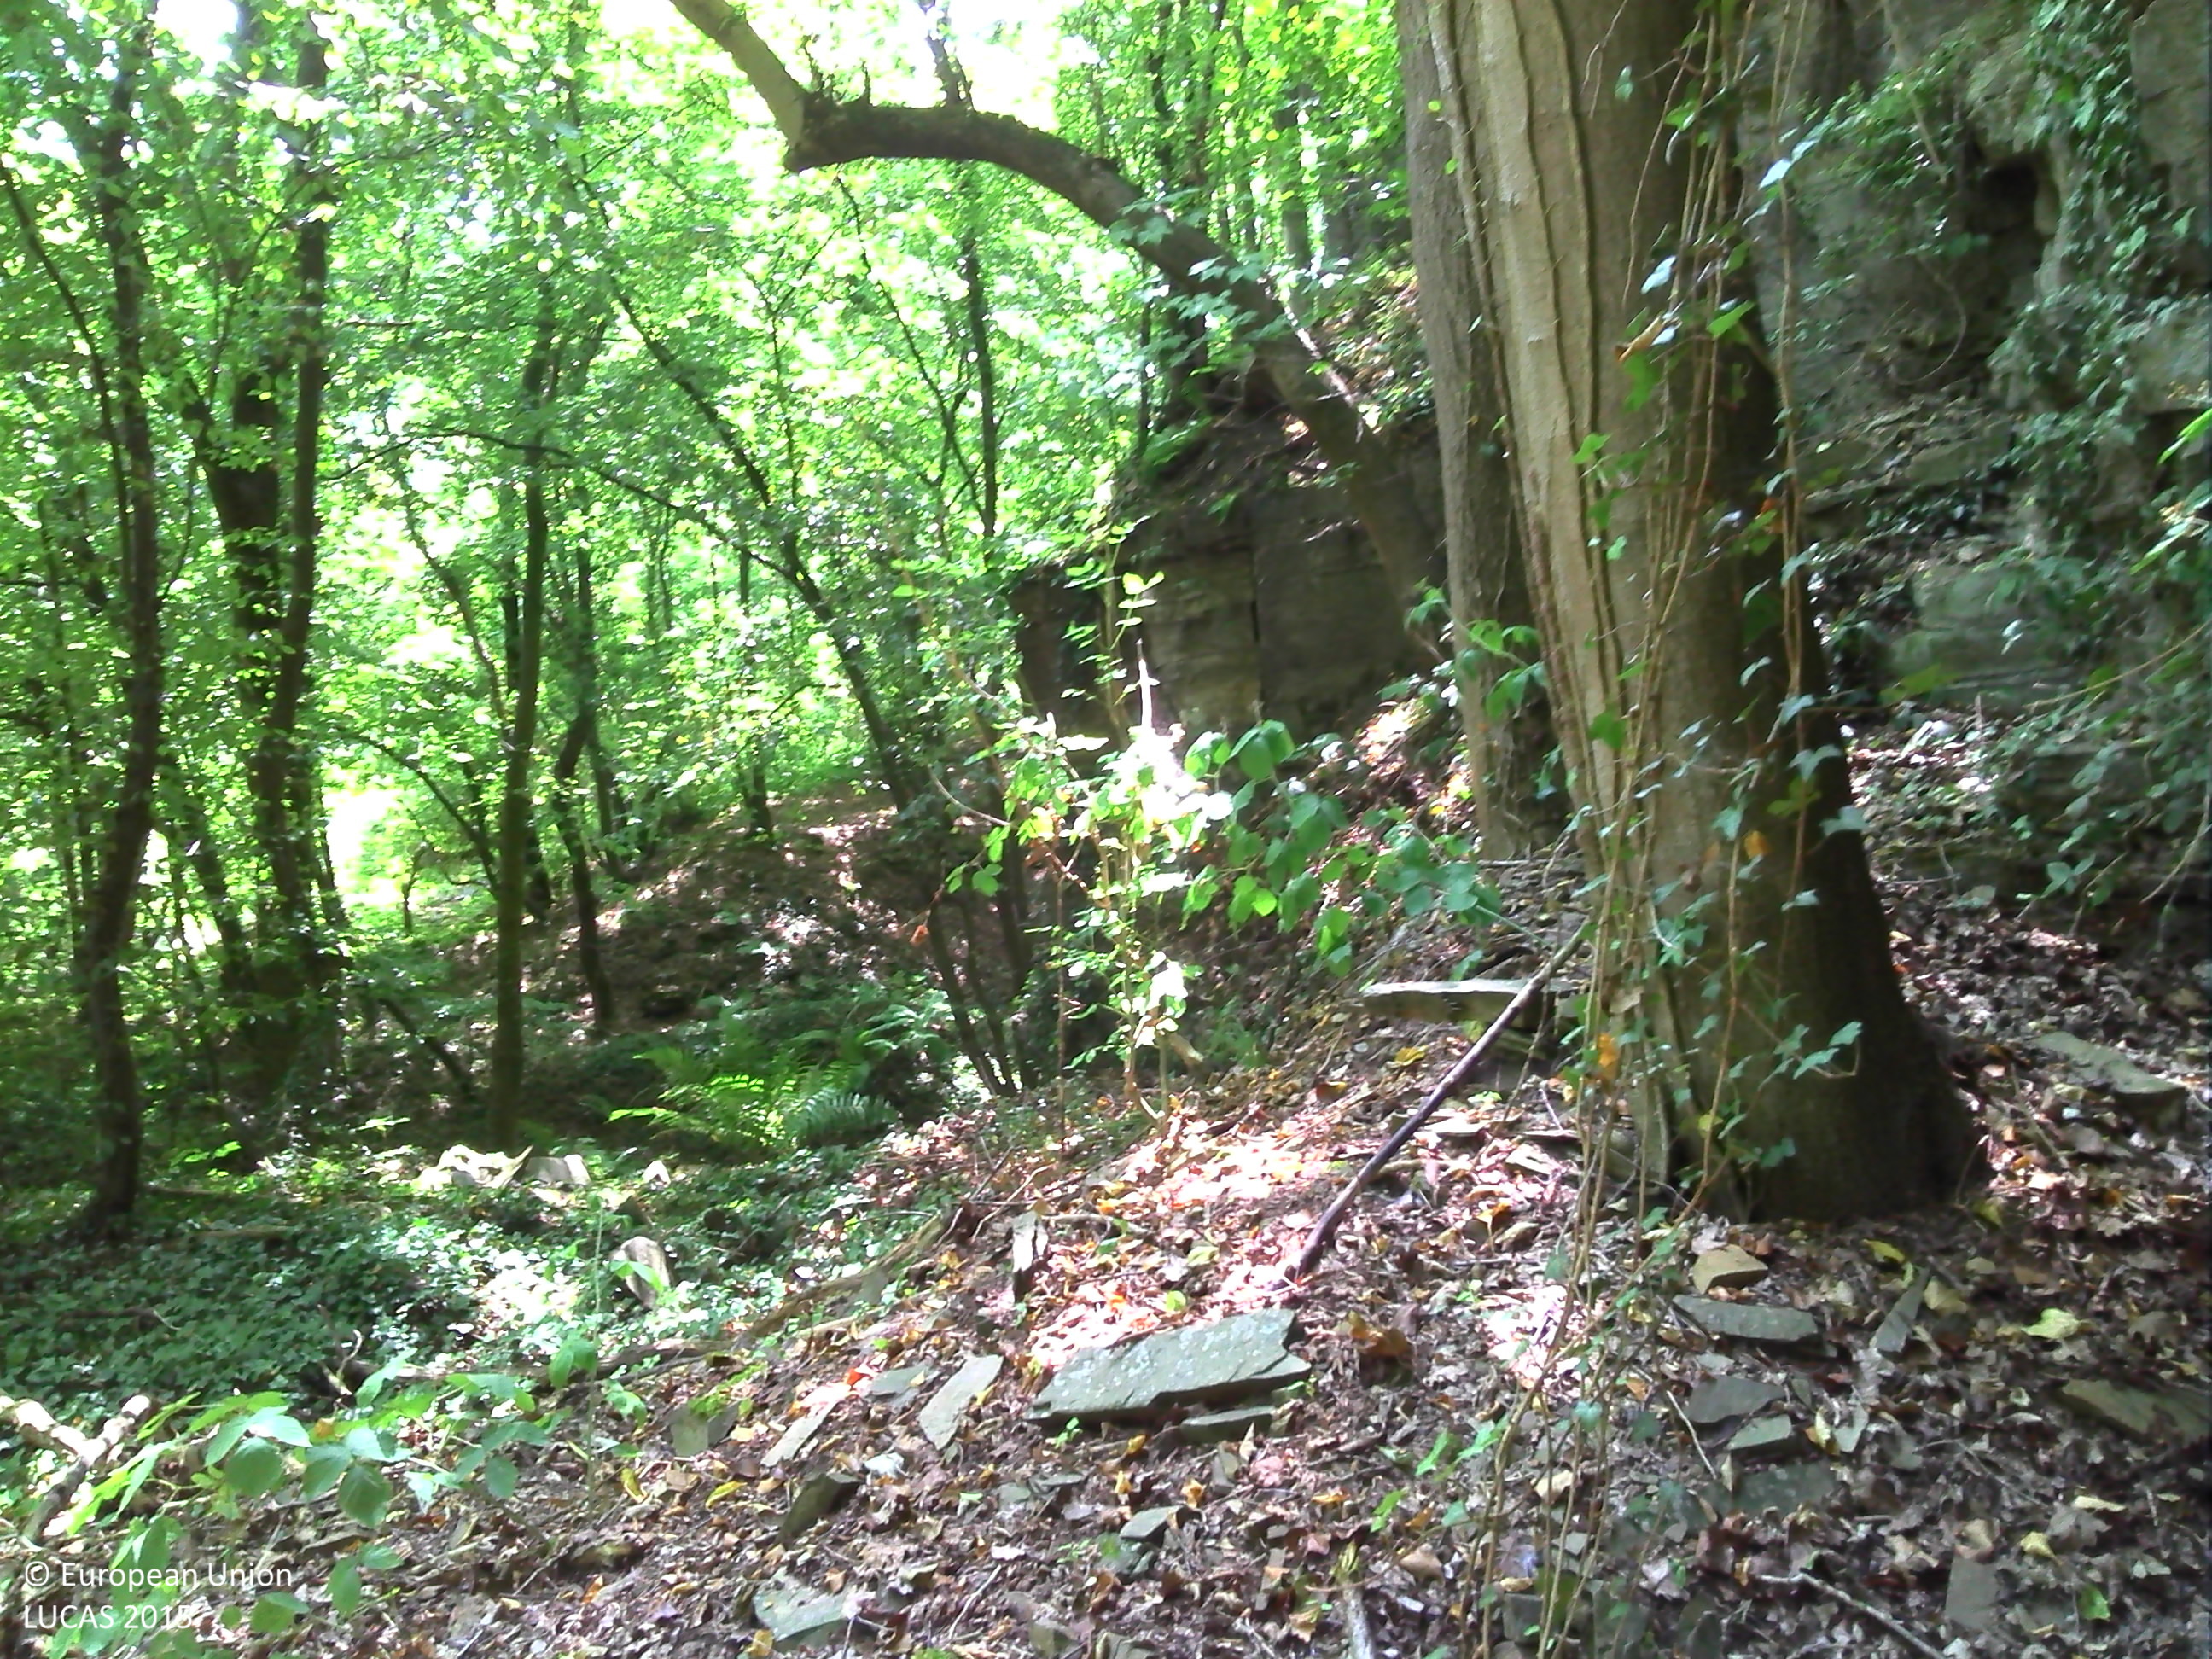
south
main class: Woodland
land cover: Broadleaved woodland
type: mesophytic deciduous forest
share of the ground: > 75 %
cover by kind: broadleaved forest trees 90 %, herbaceous plants 10 %
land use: Forestry
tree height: > 5 m
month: July
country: BE
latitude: 50.5711
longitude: 5.6921
